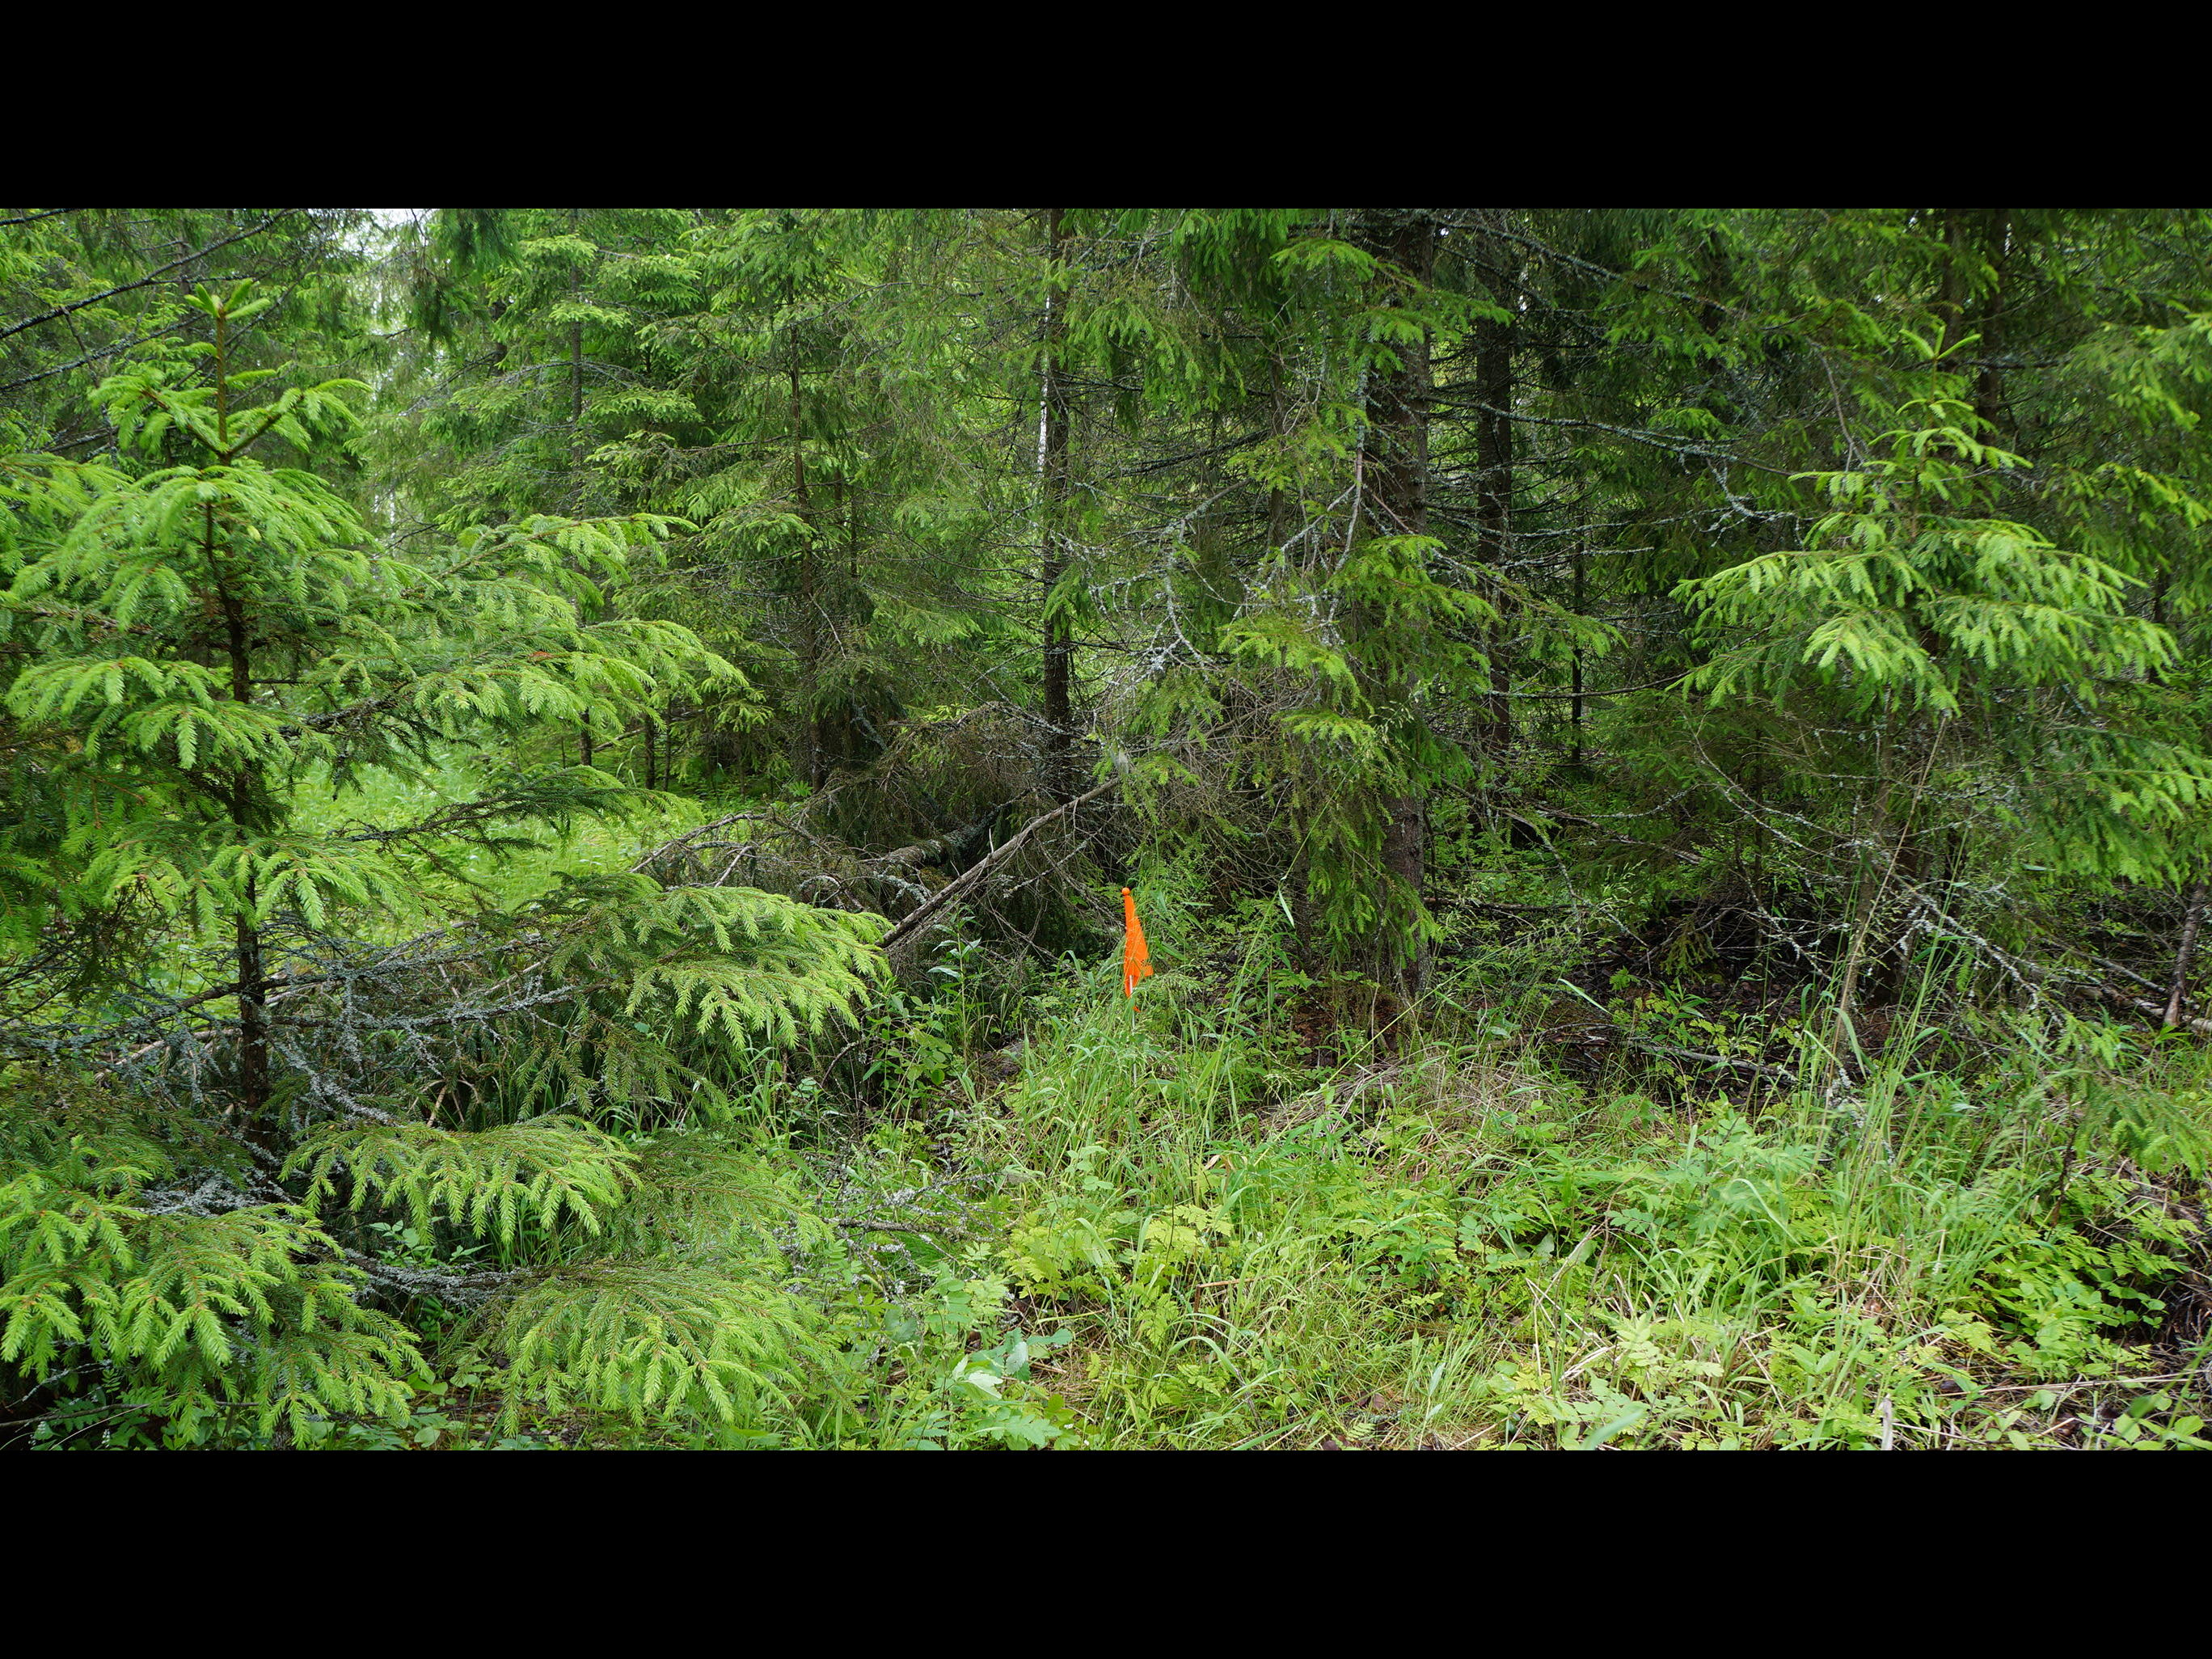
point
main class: Woodland
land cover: Spruce dominated coniferous woodland
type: boreal forest
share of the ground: 50 - 75 %
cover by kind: coniferous forest trees 45 %, shrubs 25 %, herbaceous plants 20 %, broadleaved forest trees 5 %, lichens and mosses 5 %
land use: Forestry
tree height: > 5 m
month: June
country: FI
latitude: 63.9001
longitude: 23.4009
